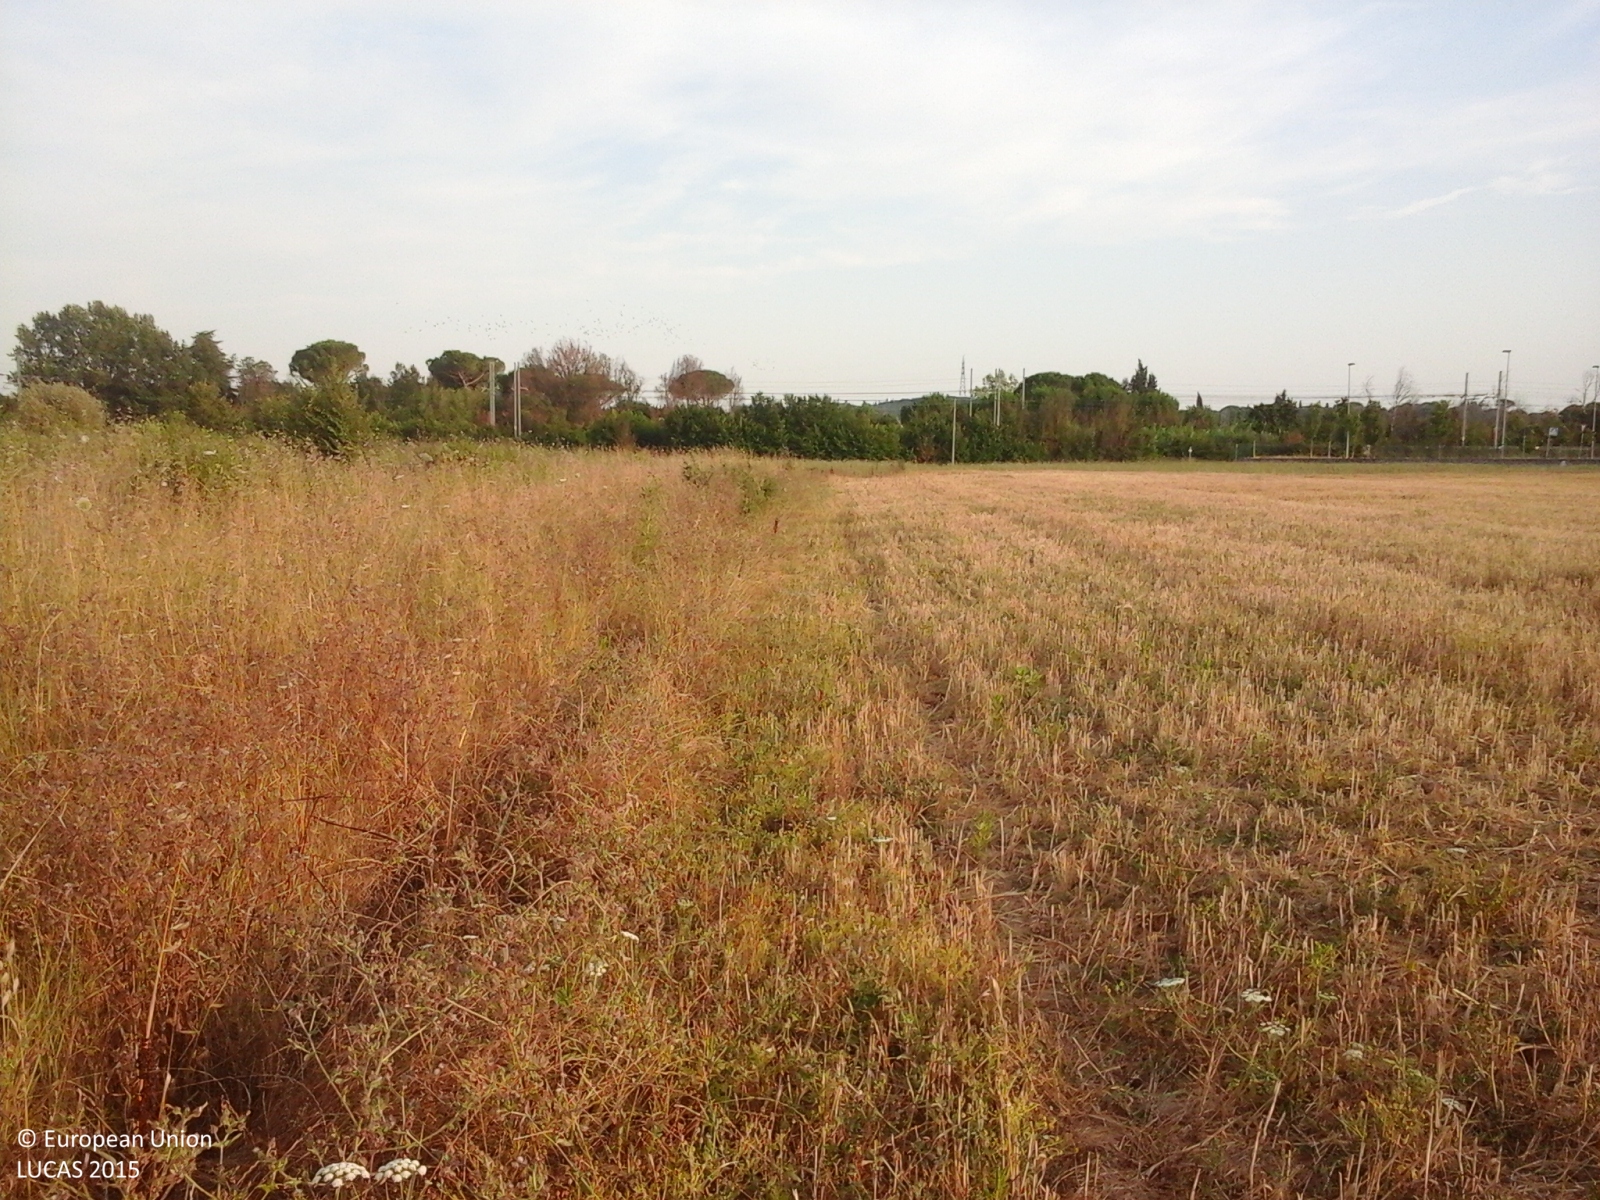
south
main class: Grassland
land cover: Grassland without tree/shrub cover
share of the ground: > 75 %
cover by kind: herbaceous plants 100 %
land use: Agriculture (excluding fallow land and kitchen gardens)
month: July
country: IT
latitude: 43.7149
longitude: 10.9284
